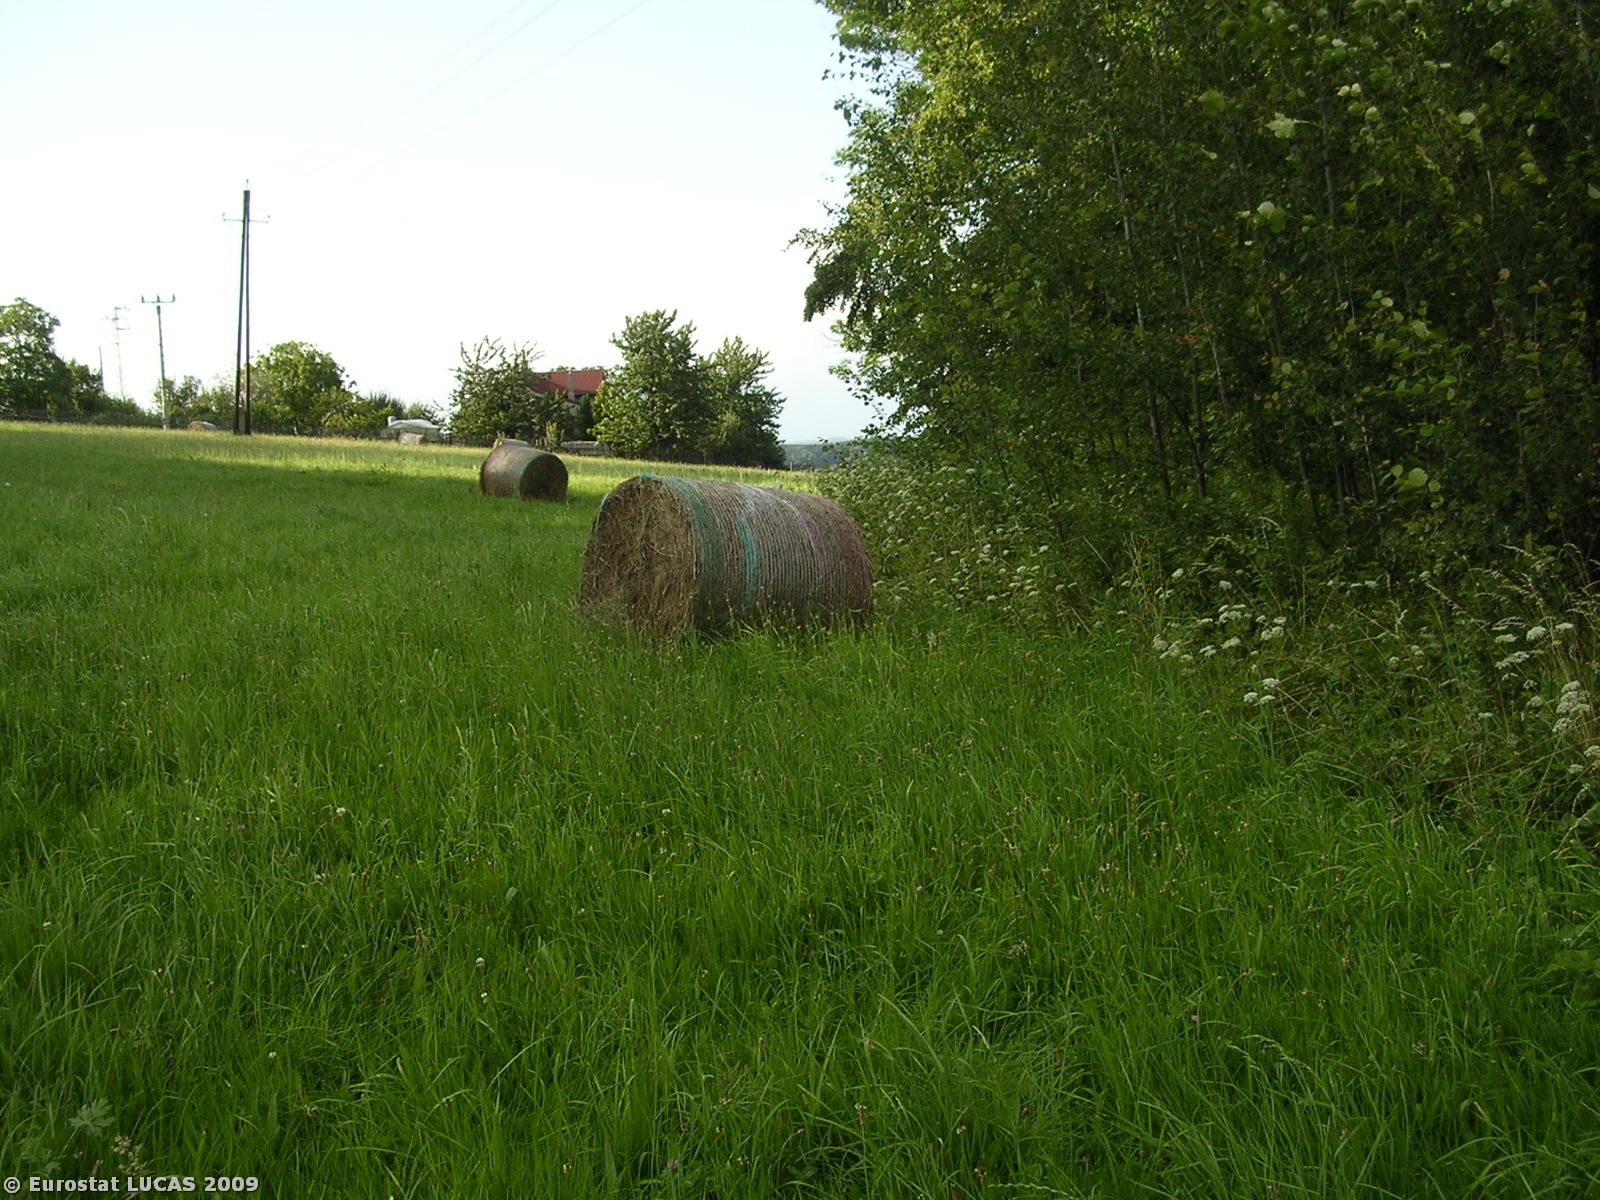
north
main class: Grassland
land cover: Grassland without tree/shrub cover
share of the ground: > 75 %
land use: Agriculture (excluding fallow land and kitchen gardens)
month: July
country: CZ
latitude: 50.9357
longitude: 15.0832
